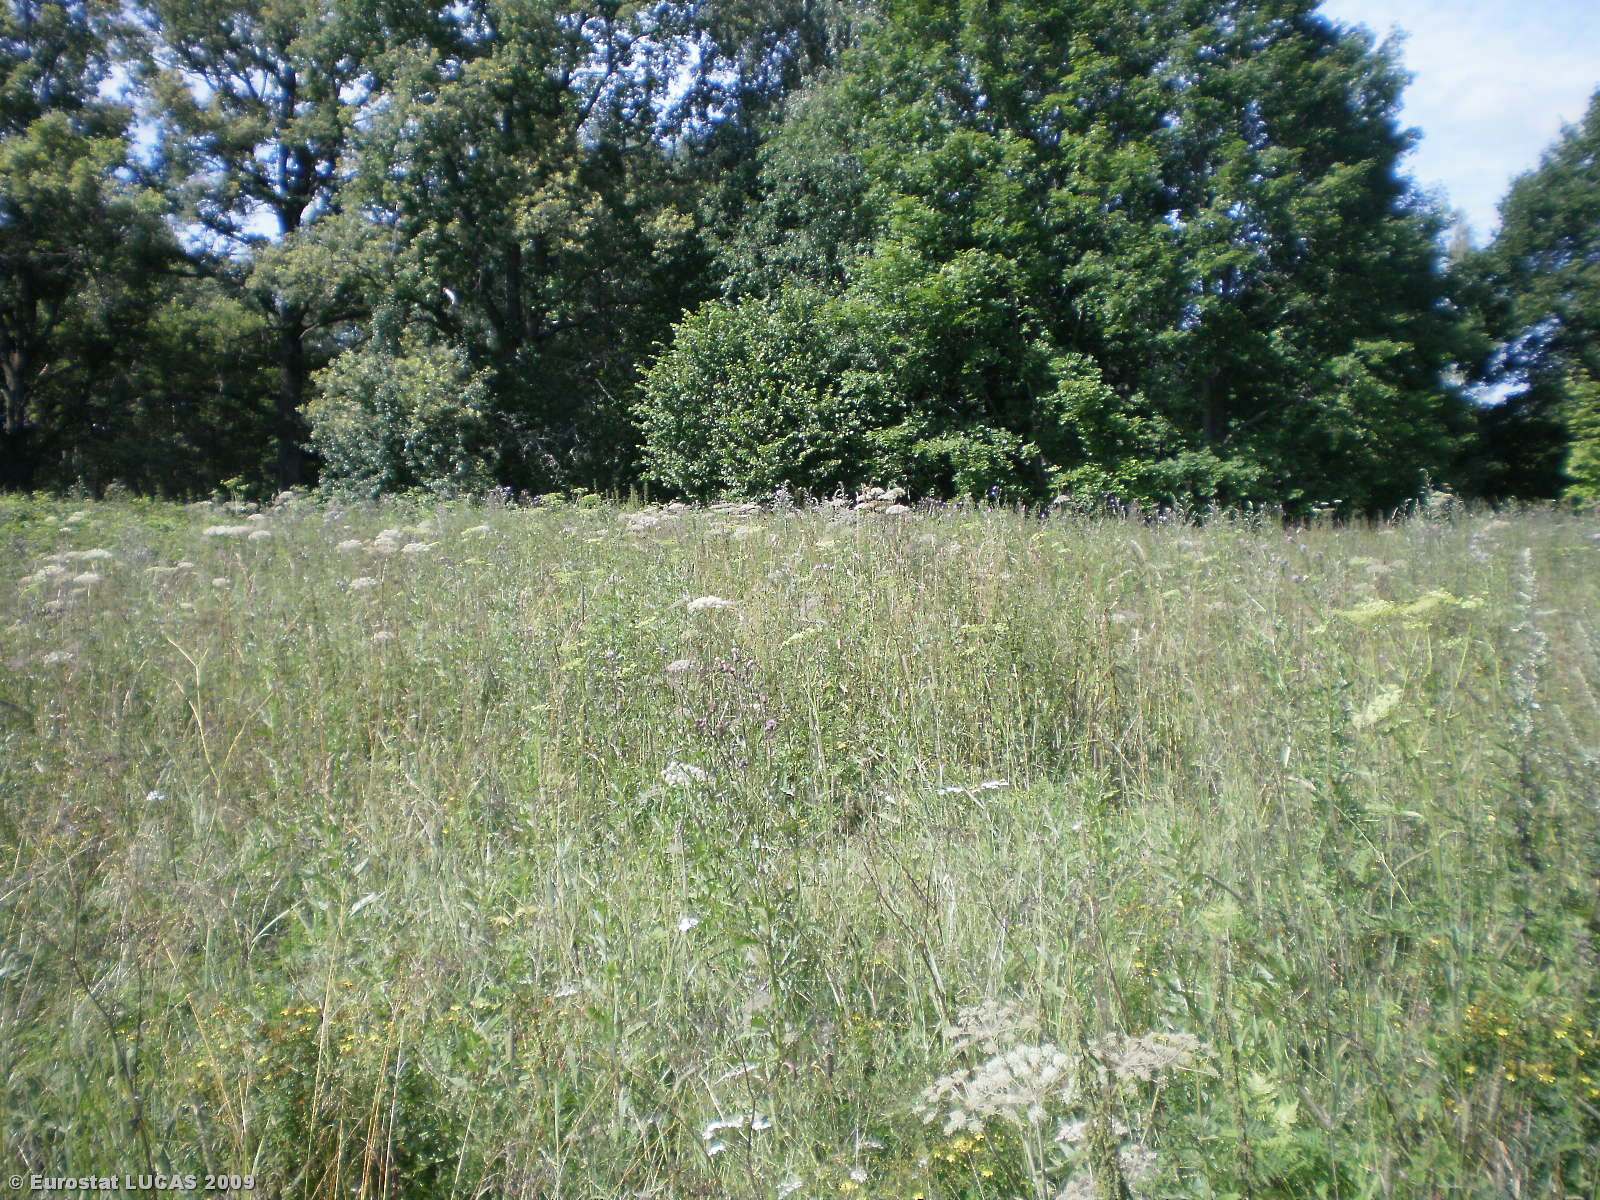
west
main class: Grassland
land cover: Grassland without tree/shrub cover
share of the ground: > 75 %
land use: Agriculture (excluding fallow land and kitchen gardens)
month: July
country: LT
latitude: 56.0584
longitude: 25.6883
